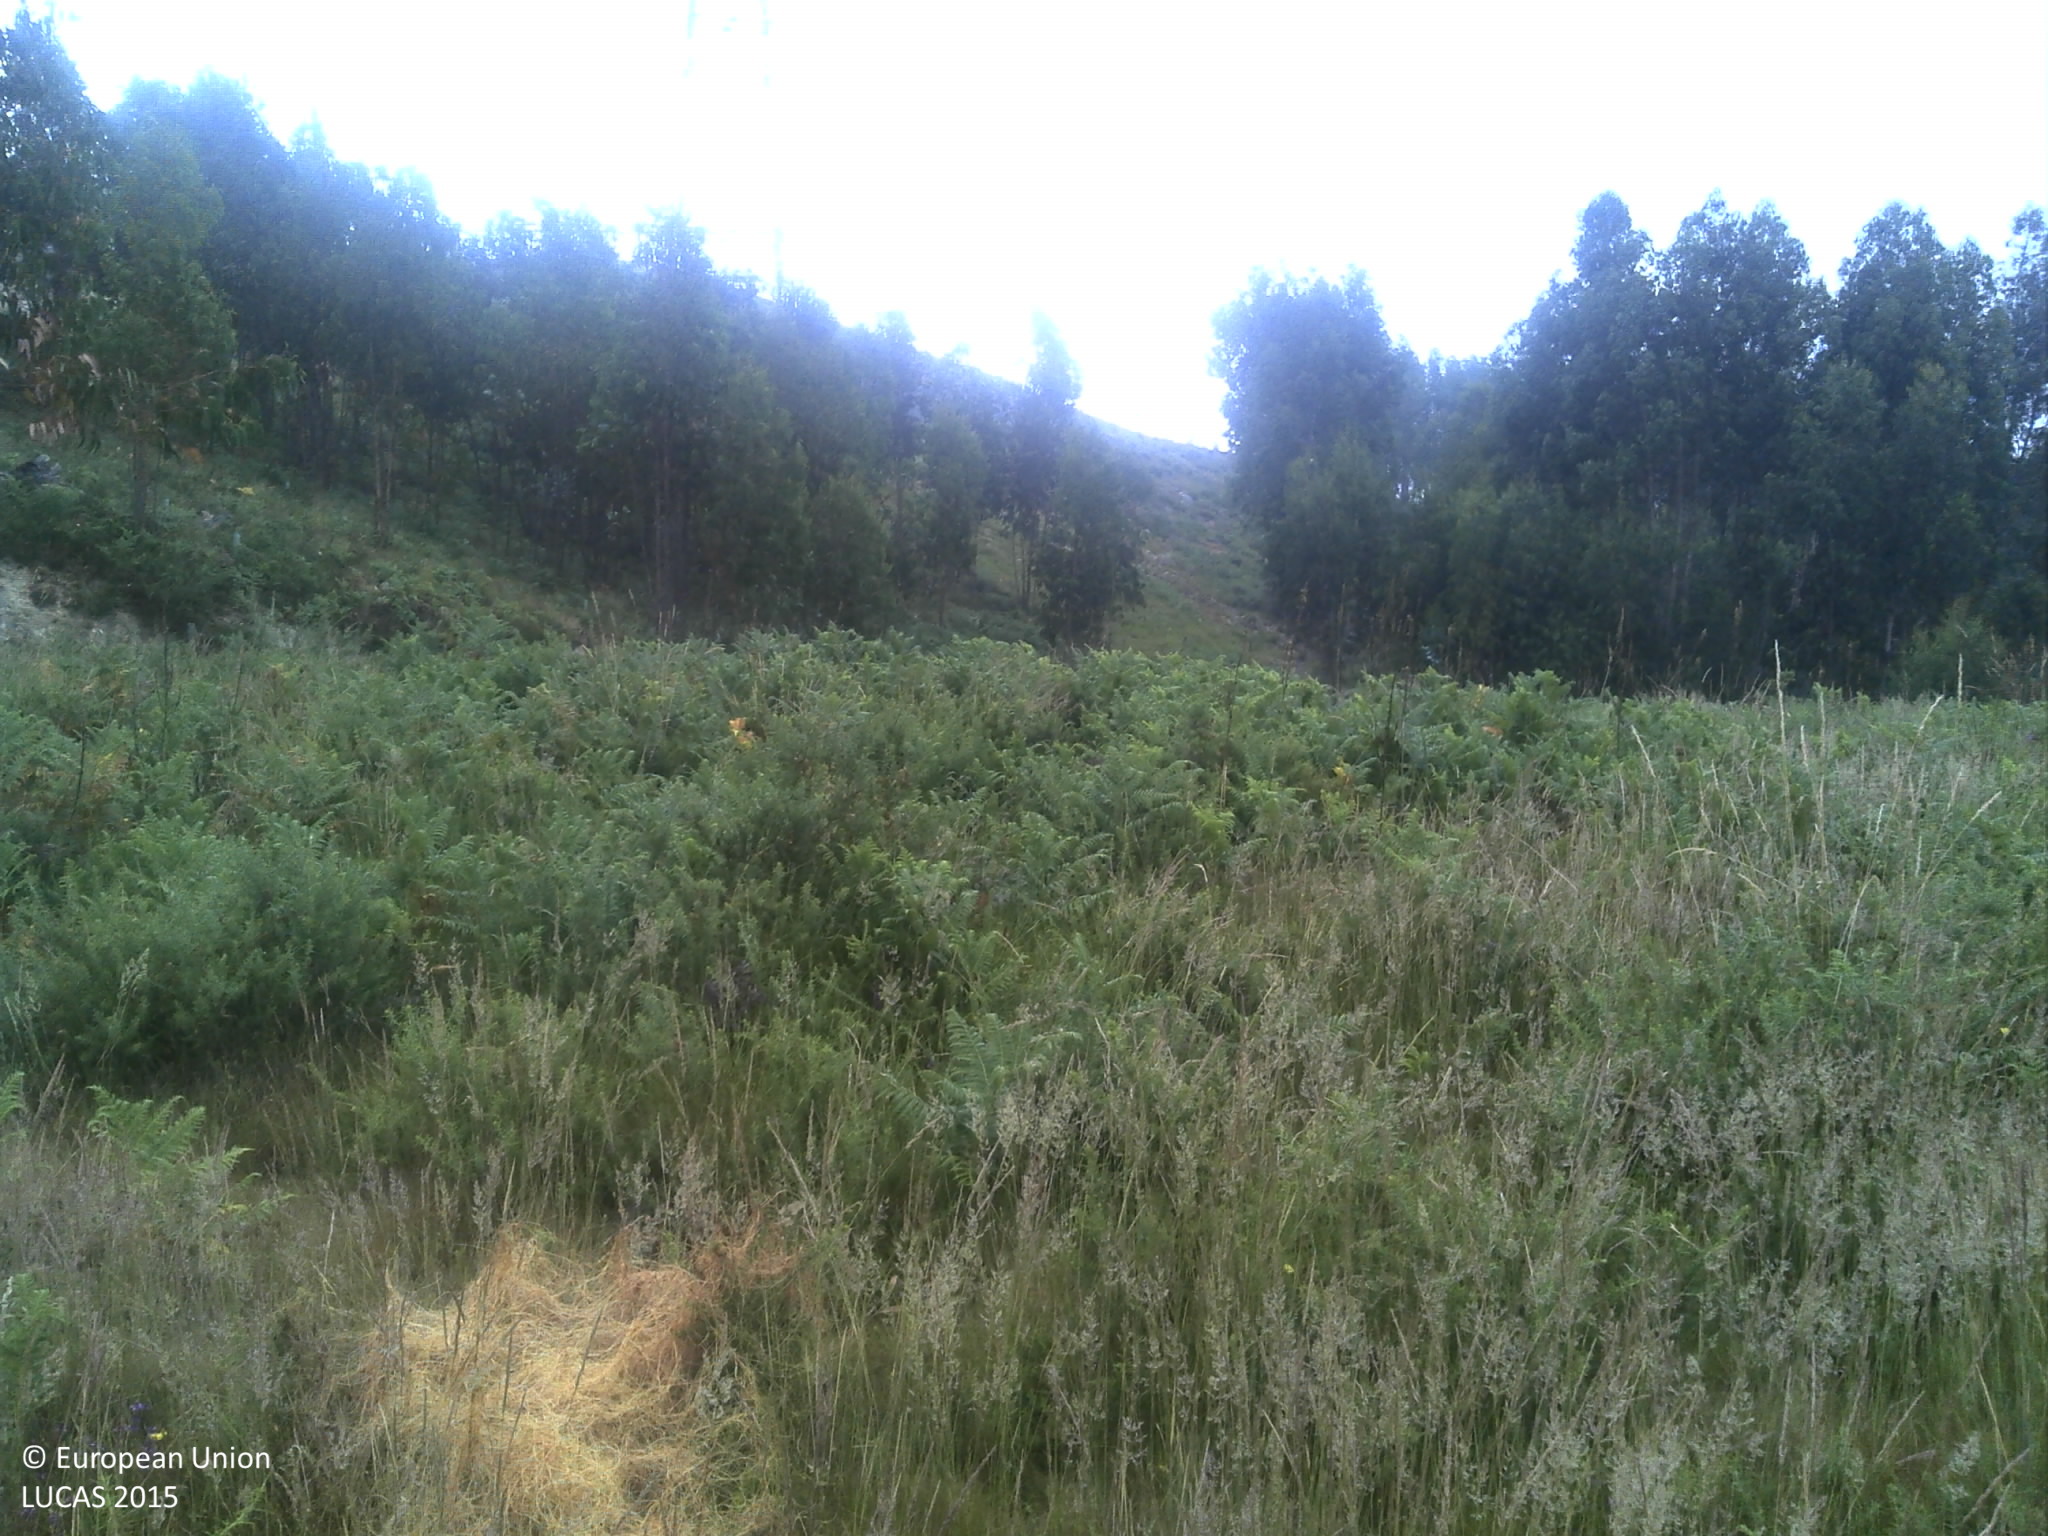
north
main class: Shrubland
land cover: Shrubland without tree cover
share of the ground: > 75 %
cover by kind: shrubs 55 %, herbaceous plants 40 %, unconsolidated bare surface 5 %
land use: Agriculture (excluding fallow land and kitchen gardens)
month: June
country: PT
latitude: 41.5755
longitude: -8.3212
